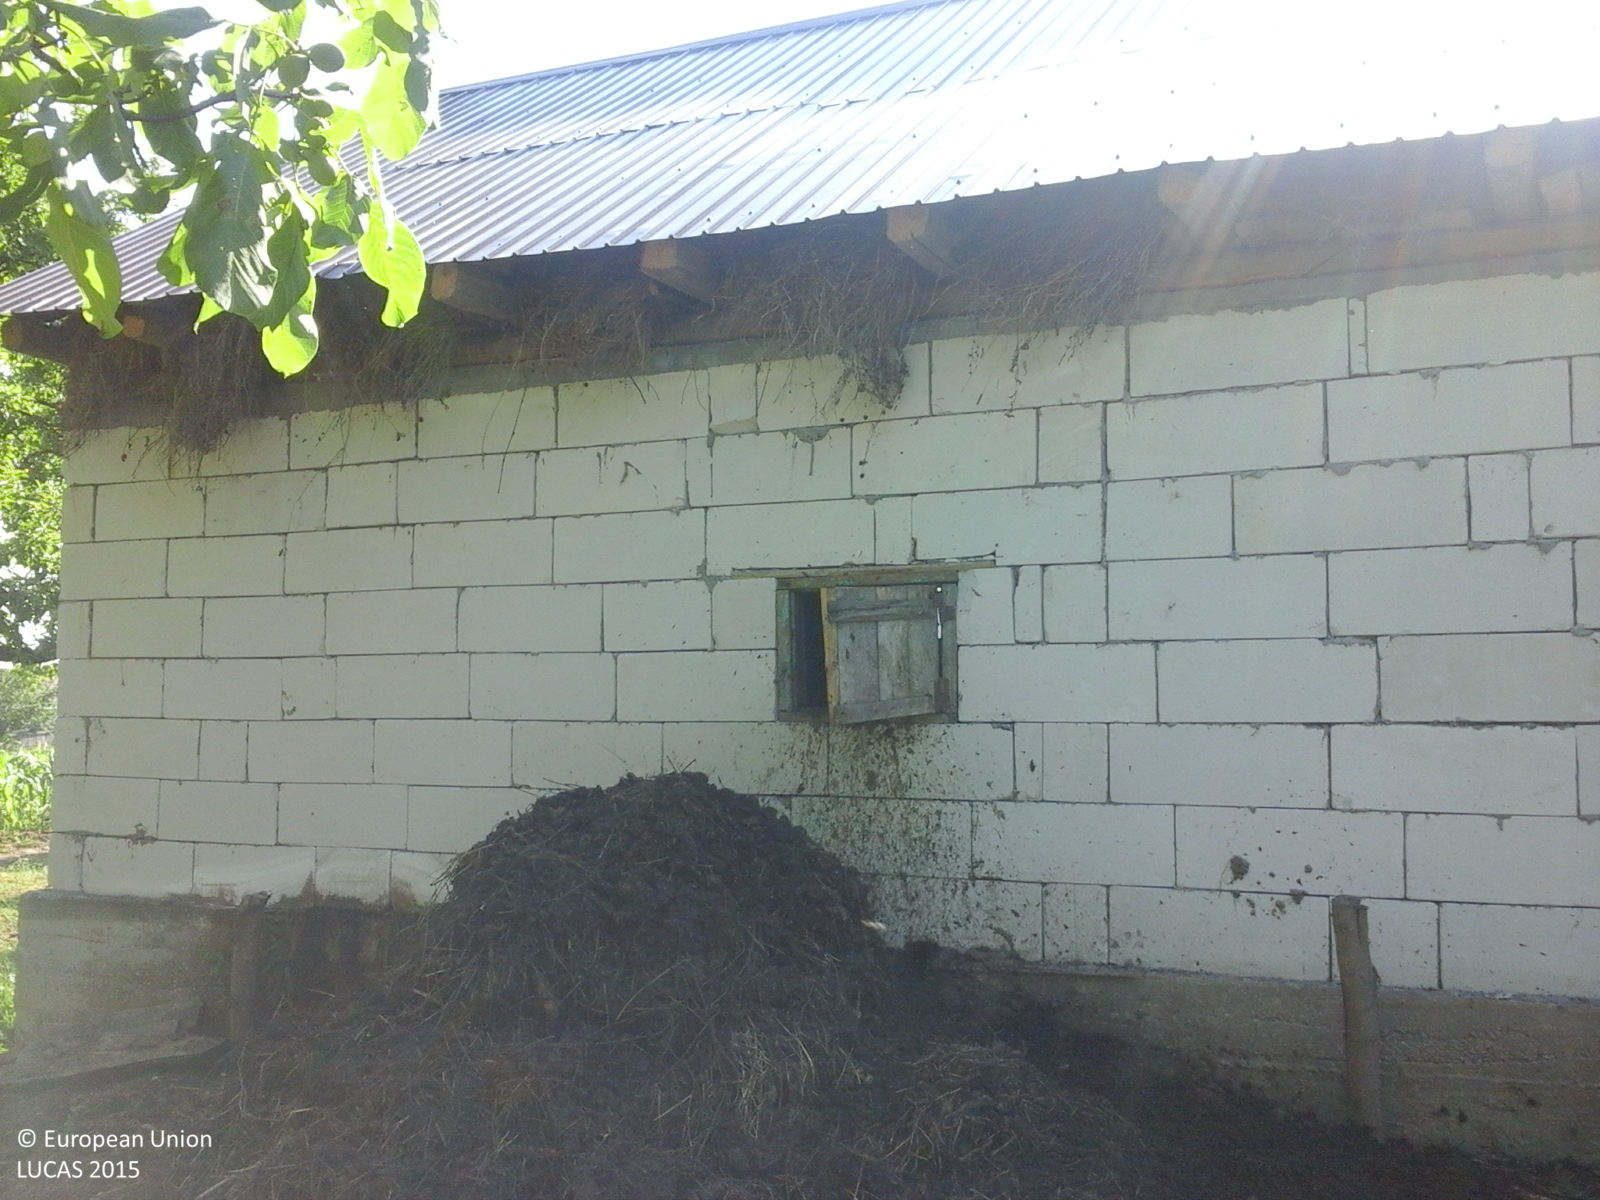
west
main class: Grassland
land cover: Grassland with sparse tree/shrub cover
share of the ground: > 75 %
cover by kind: herbaceous plants 85 %, shrubs 10 %, broadleaved forest trees 5 %
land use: Agriculture (excluding fallow land and kitchen gardens)
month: June
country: RO
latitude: 47.4460
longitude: 26.7386
